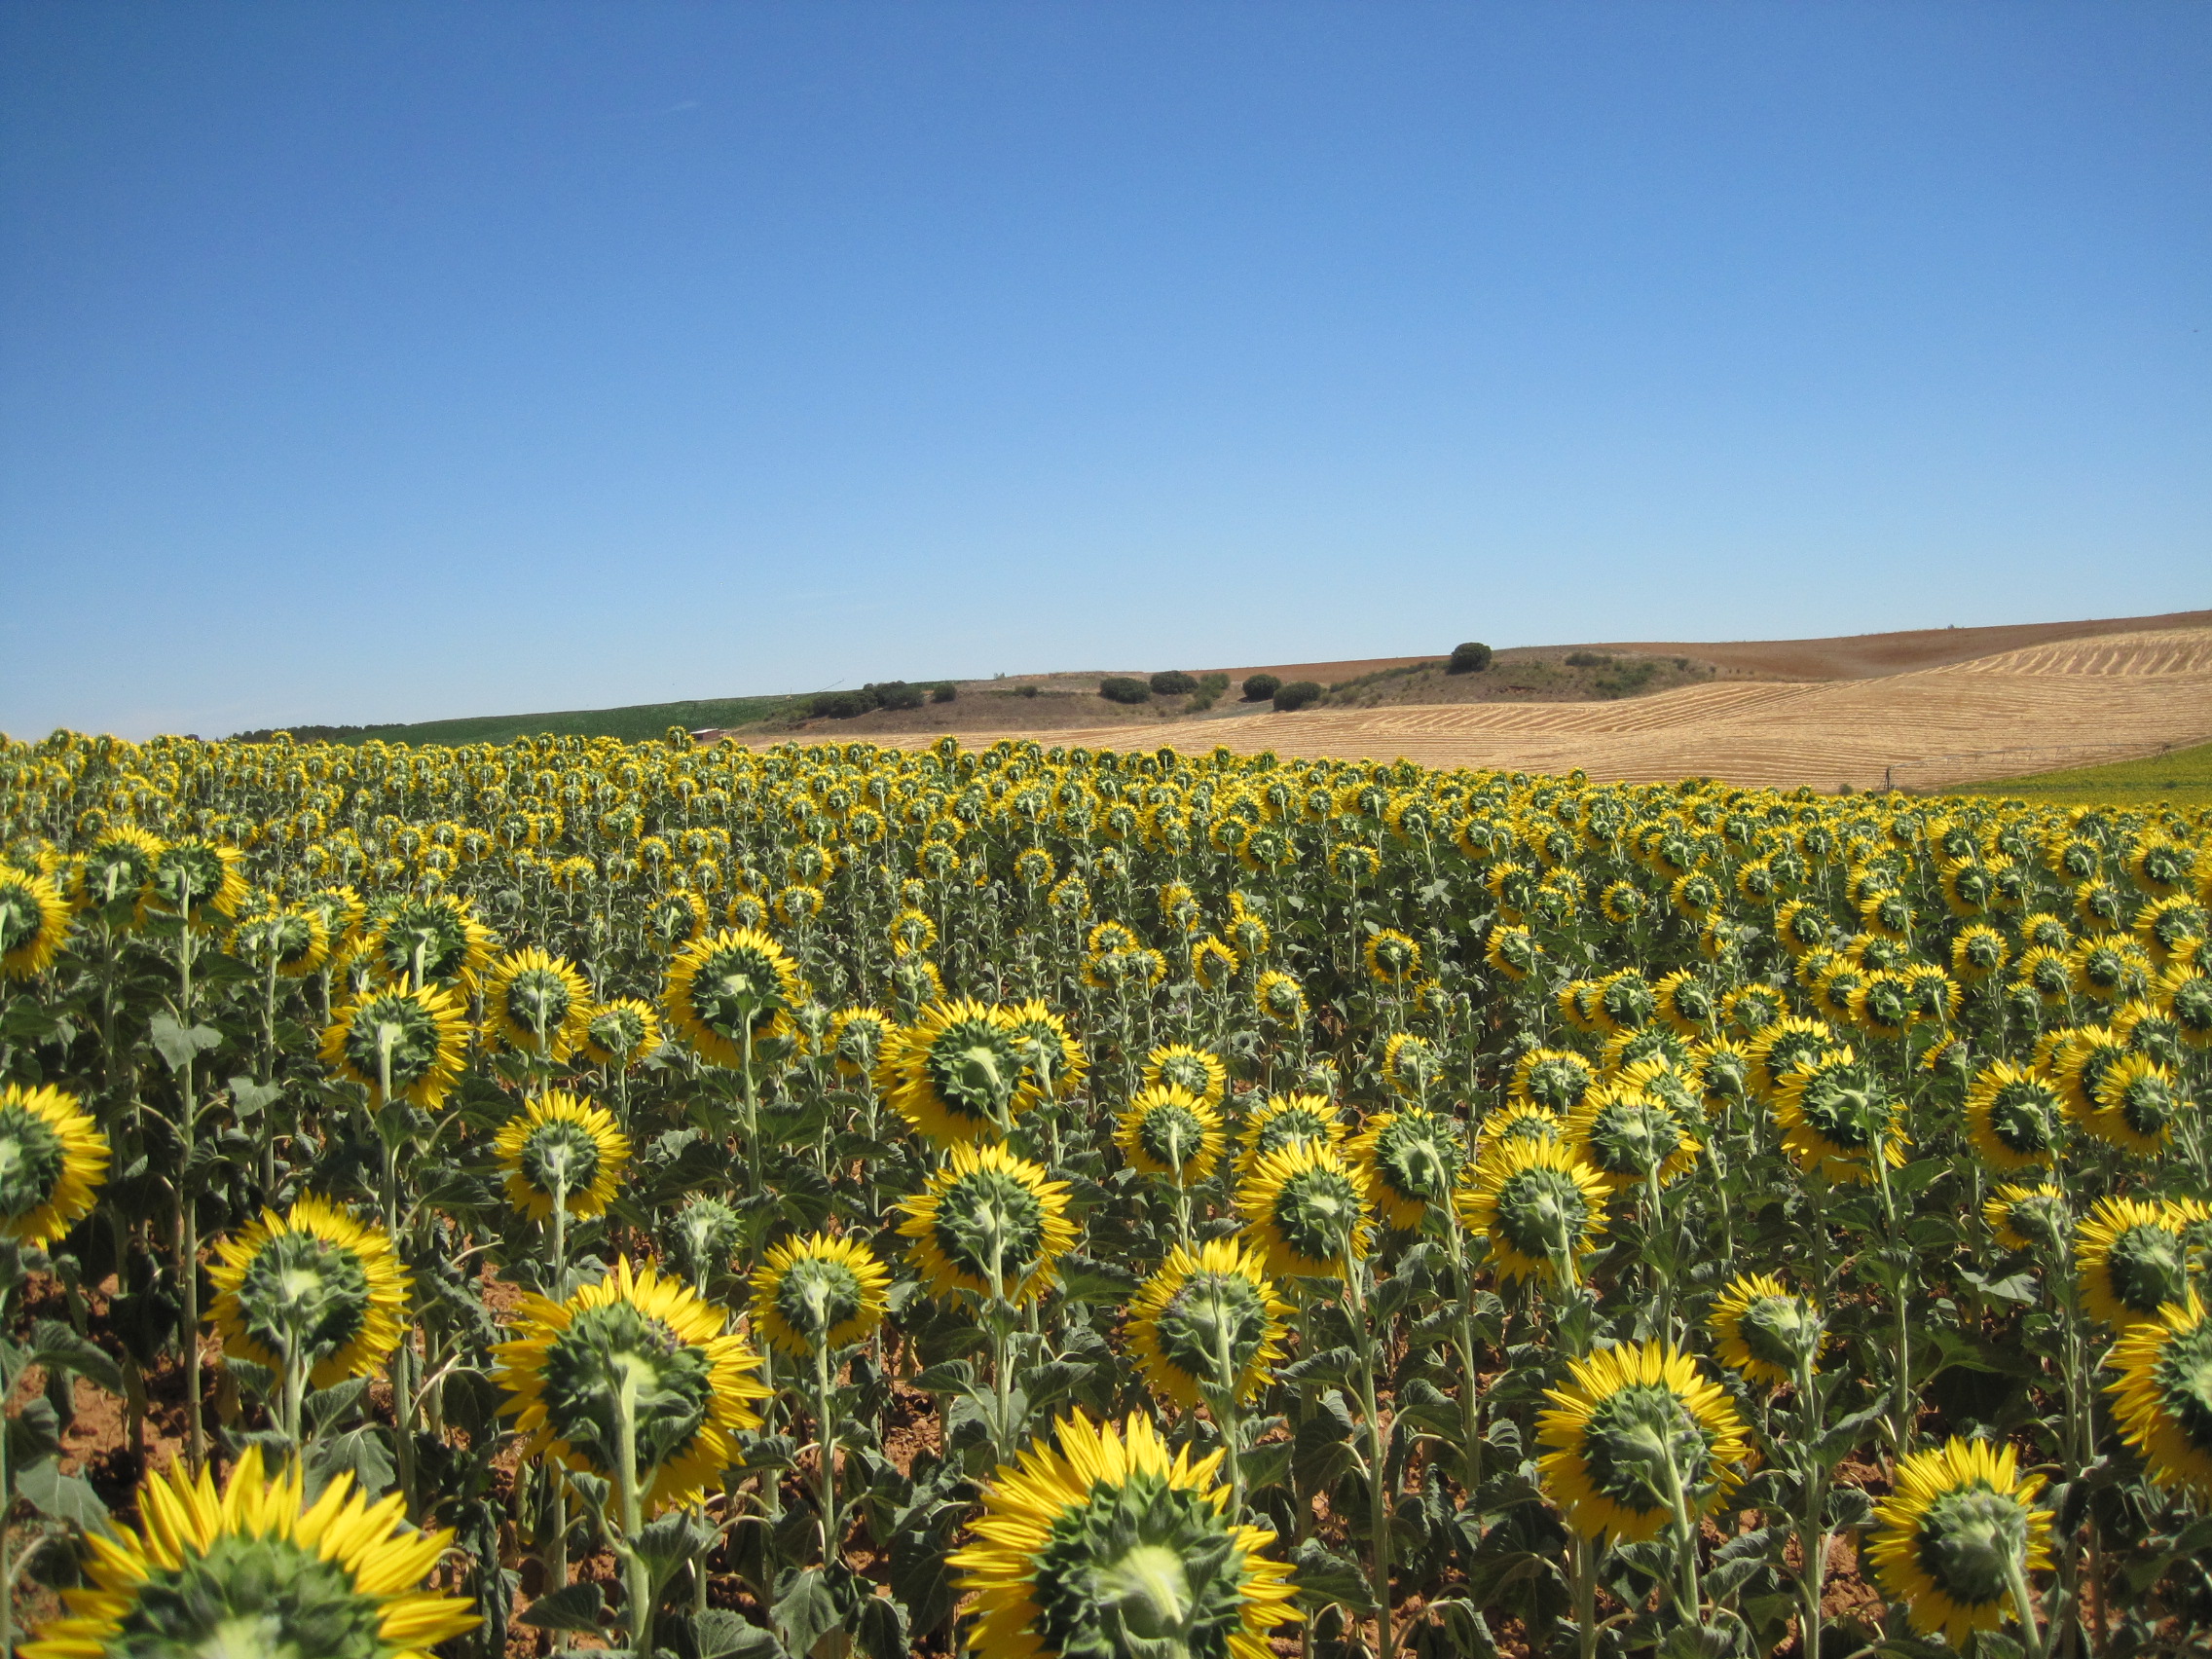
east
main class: Cropland
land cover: Sunflower
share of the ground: > 75 %
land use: Agriculture (excluding fallow land and kitchen gardens)
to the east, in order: Sunflower; Grass margins; Common wheat
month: July
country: ES
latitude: 42.1544
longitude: -5.4713
